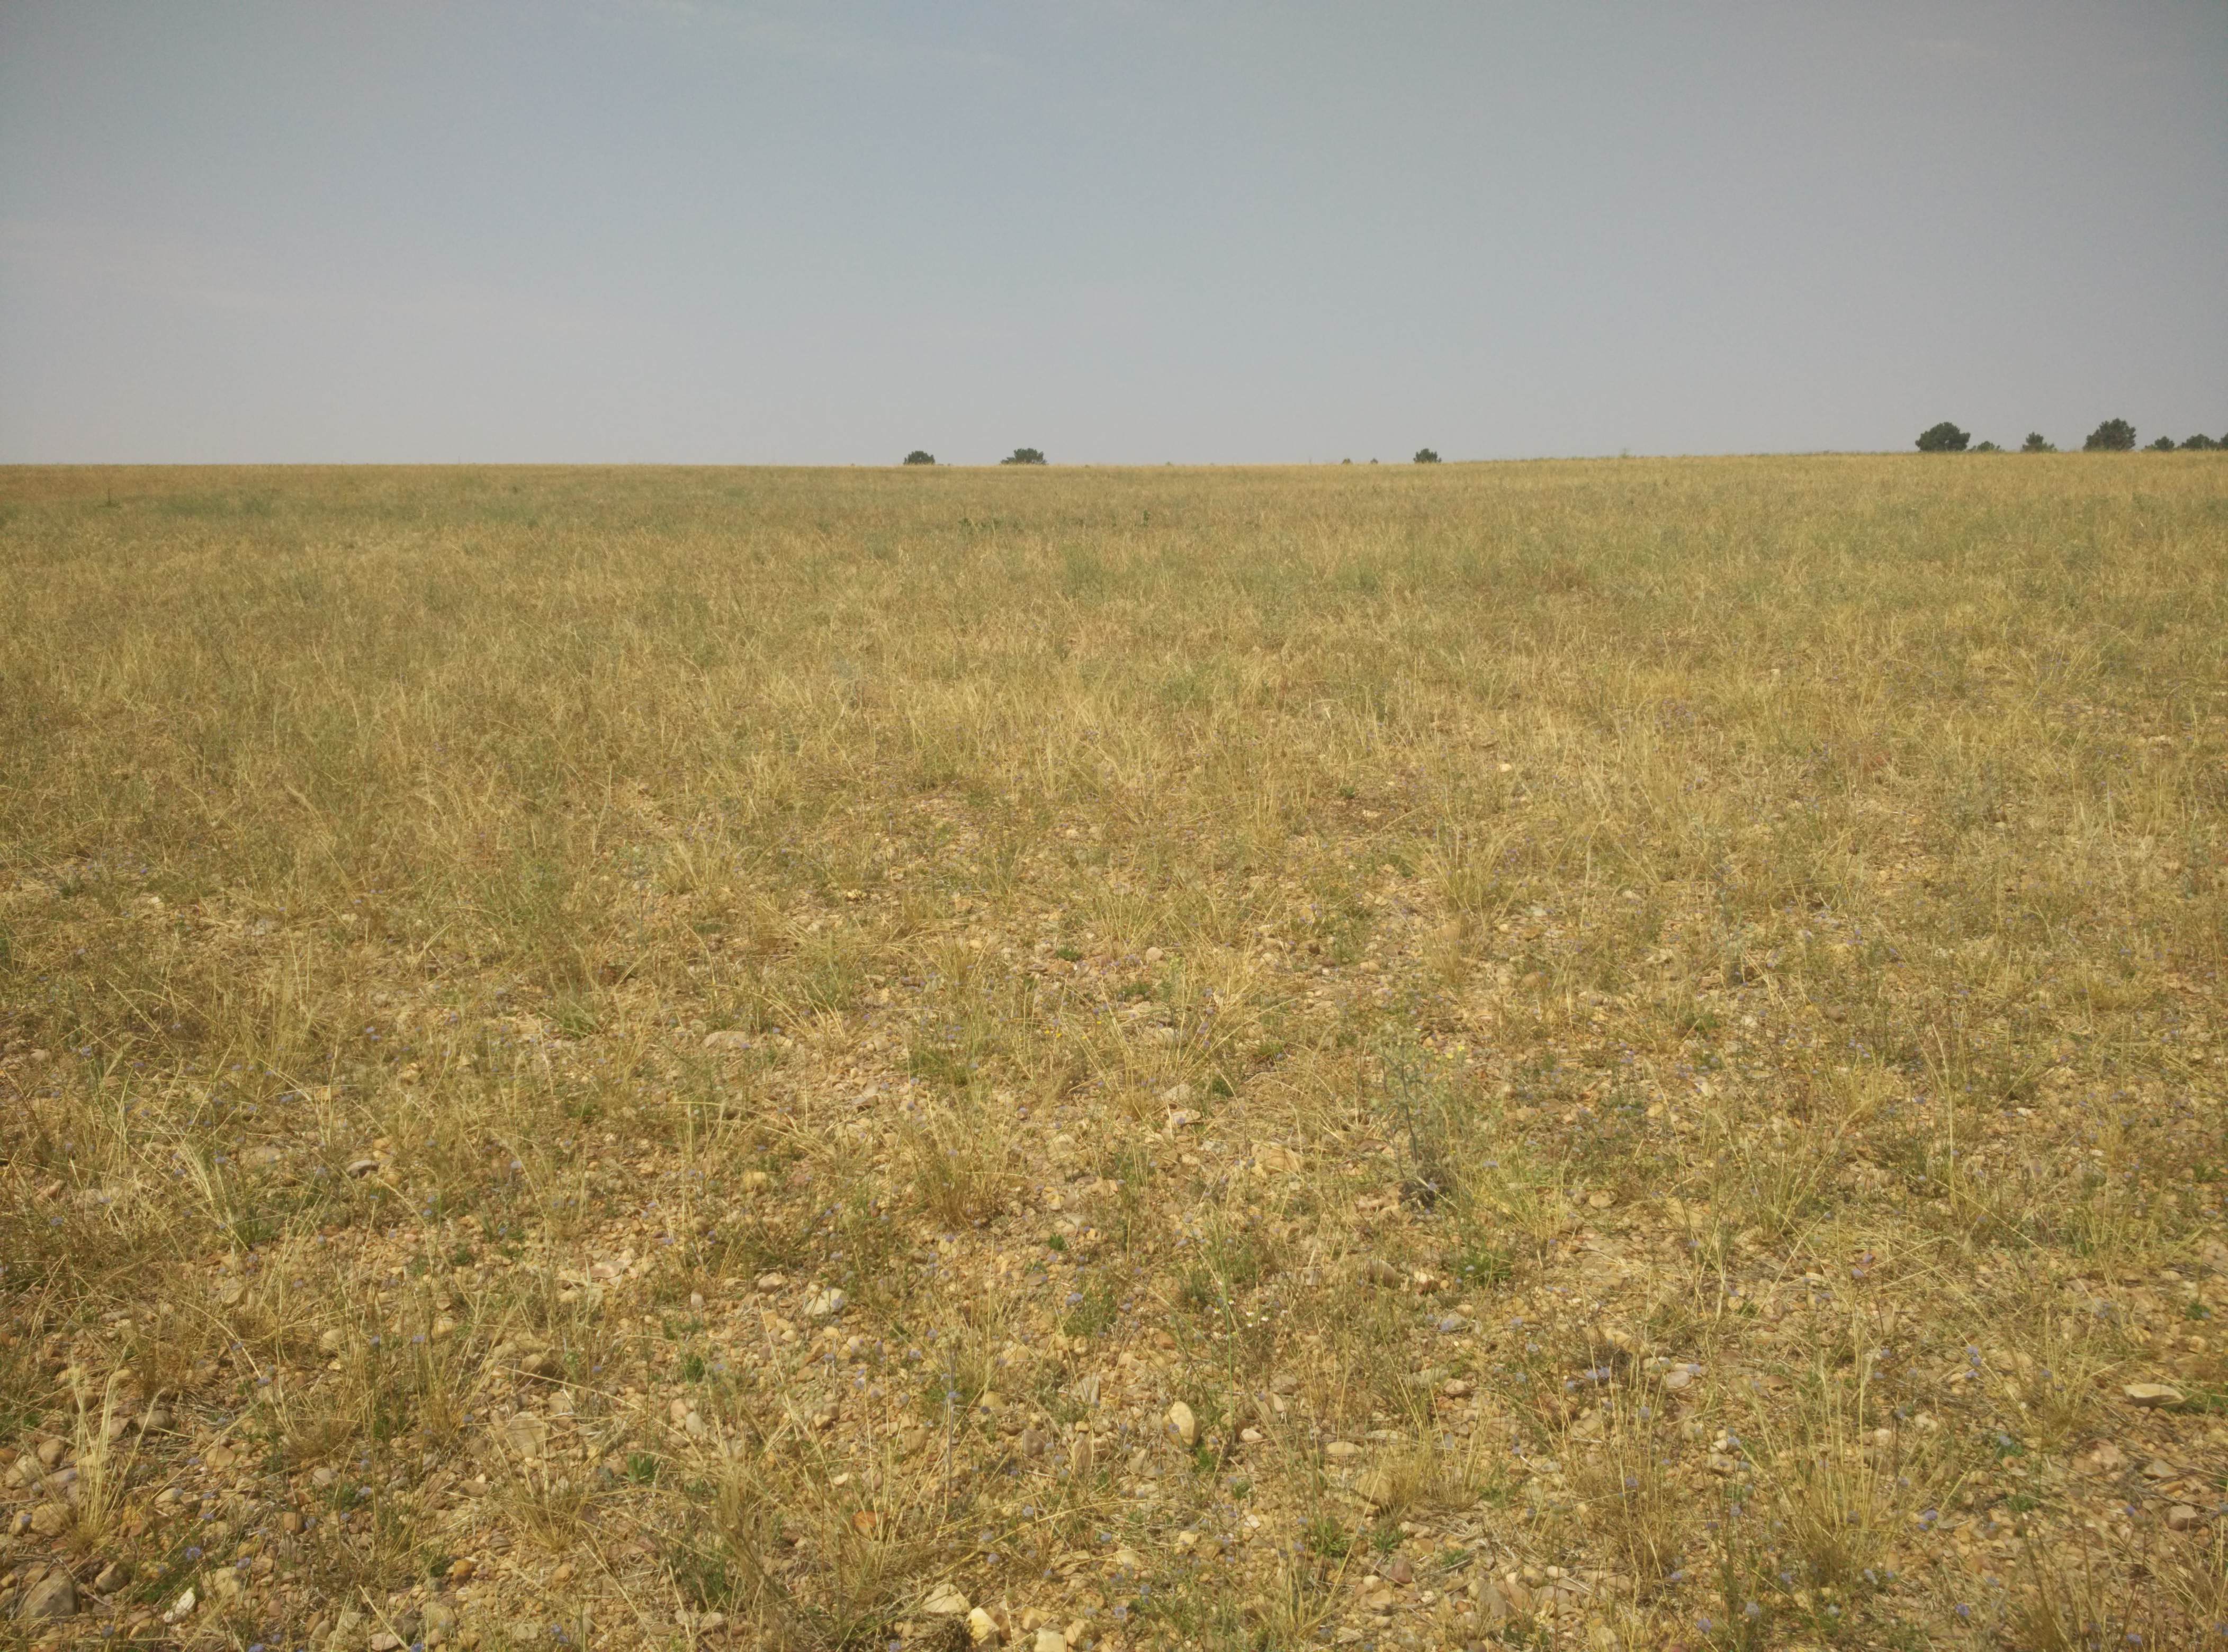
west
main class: Grassland
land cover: Spontaneously vegetated surfaces
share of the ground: > 75 %
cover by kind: herbaceous plants 75 %, unconsolidated bare surface 25 %
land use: Fallow land
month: June
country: ES
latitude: 40.8584
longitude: -1.8735
